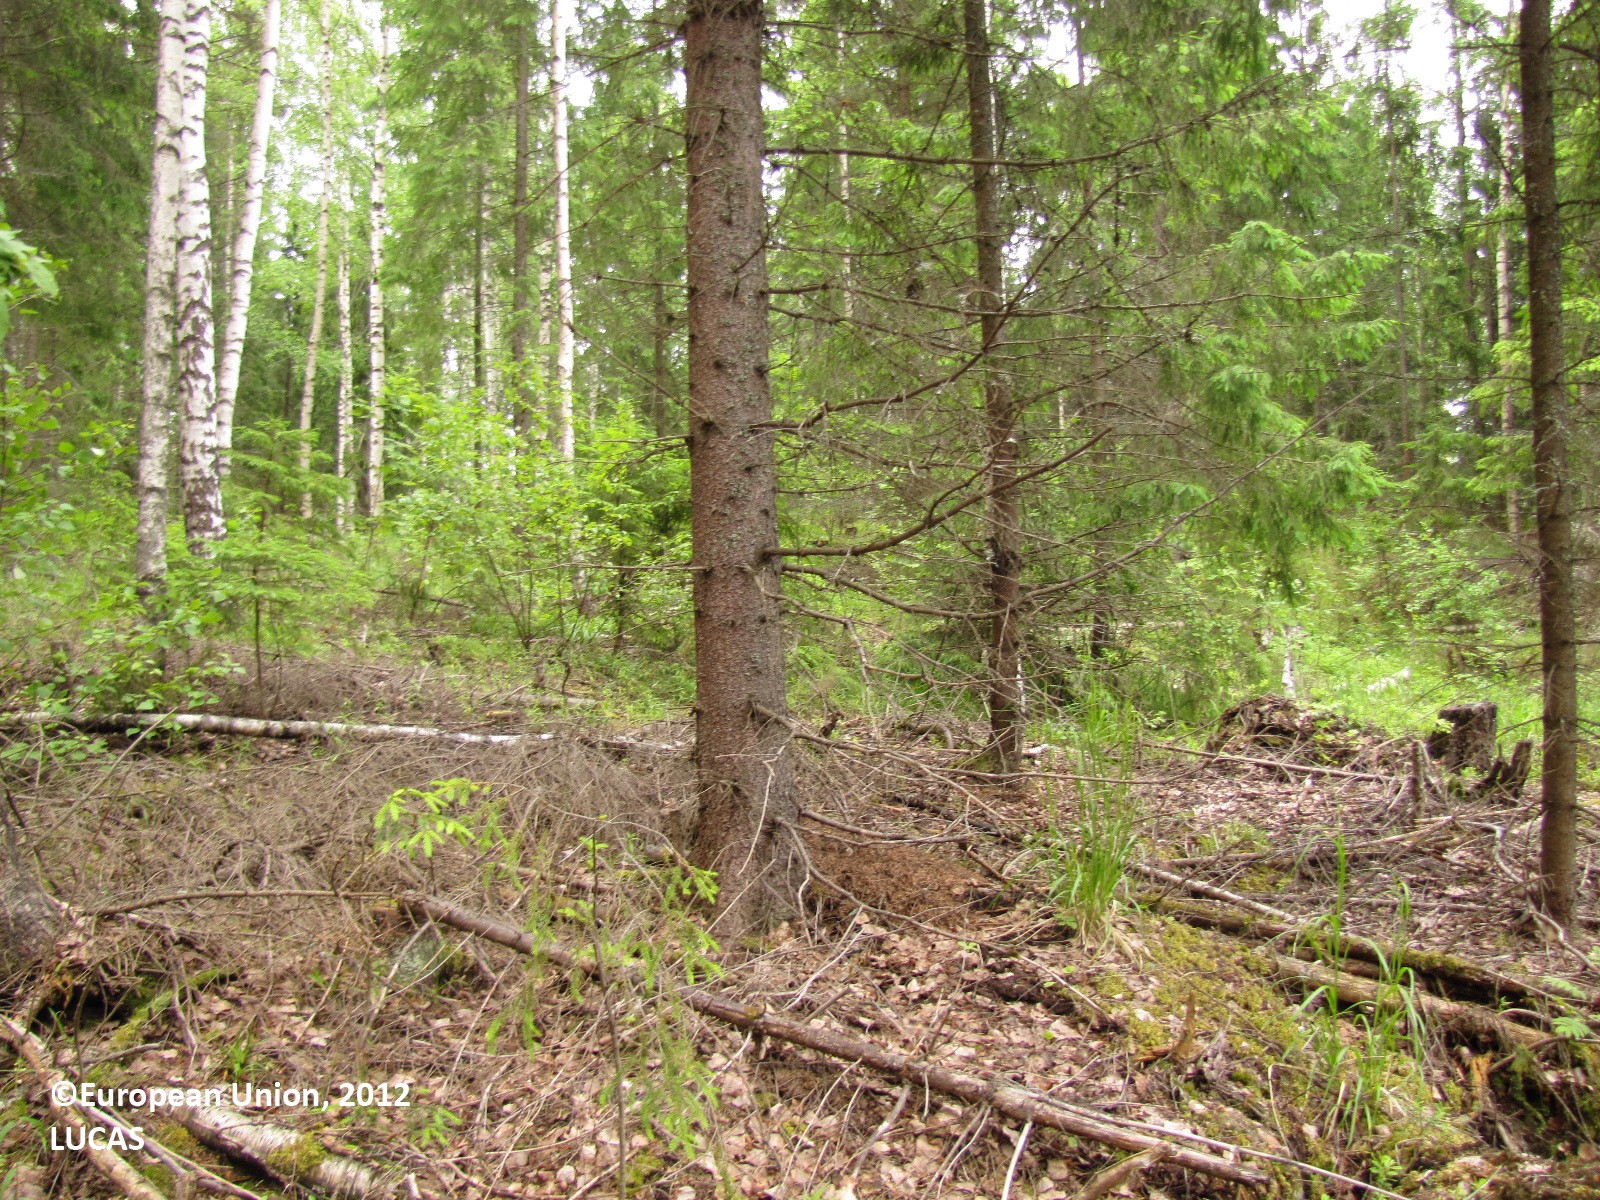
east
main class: Woodland
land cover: Spruce dominated mixed woodland
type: boreal forest
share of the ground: 50 - 75 %
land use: Forestry
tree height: > 5 m
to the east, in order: Spruce dominated mixed woodland; Tracks; Spruce dominated mixed woodland; Grass margins; Spruce dominated mixed woodland; Spruce dominated coniferous woodland; Spruce dominated mixed woodland; Shruby margins; Ditches and canals; Paved roads, cycling and walking lanes; Grass margins; Ditches and canals; Grassland without tree/shrub cover
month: June
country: FI
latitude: 61.2437
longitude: 24.3143
